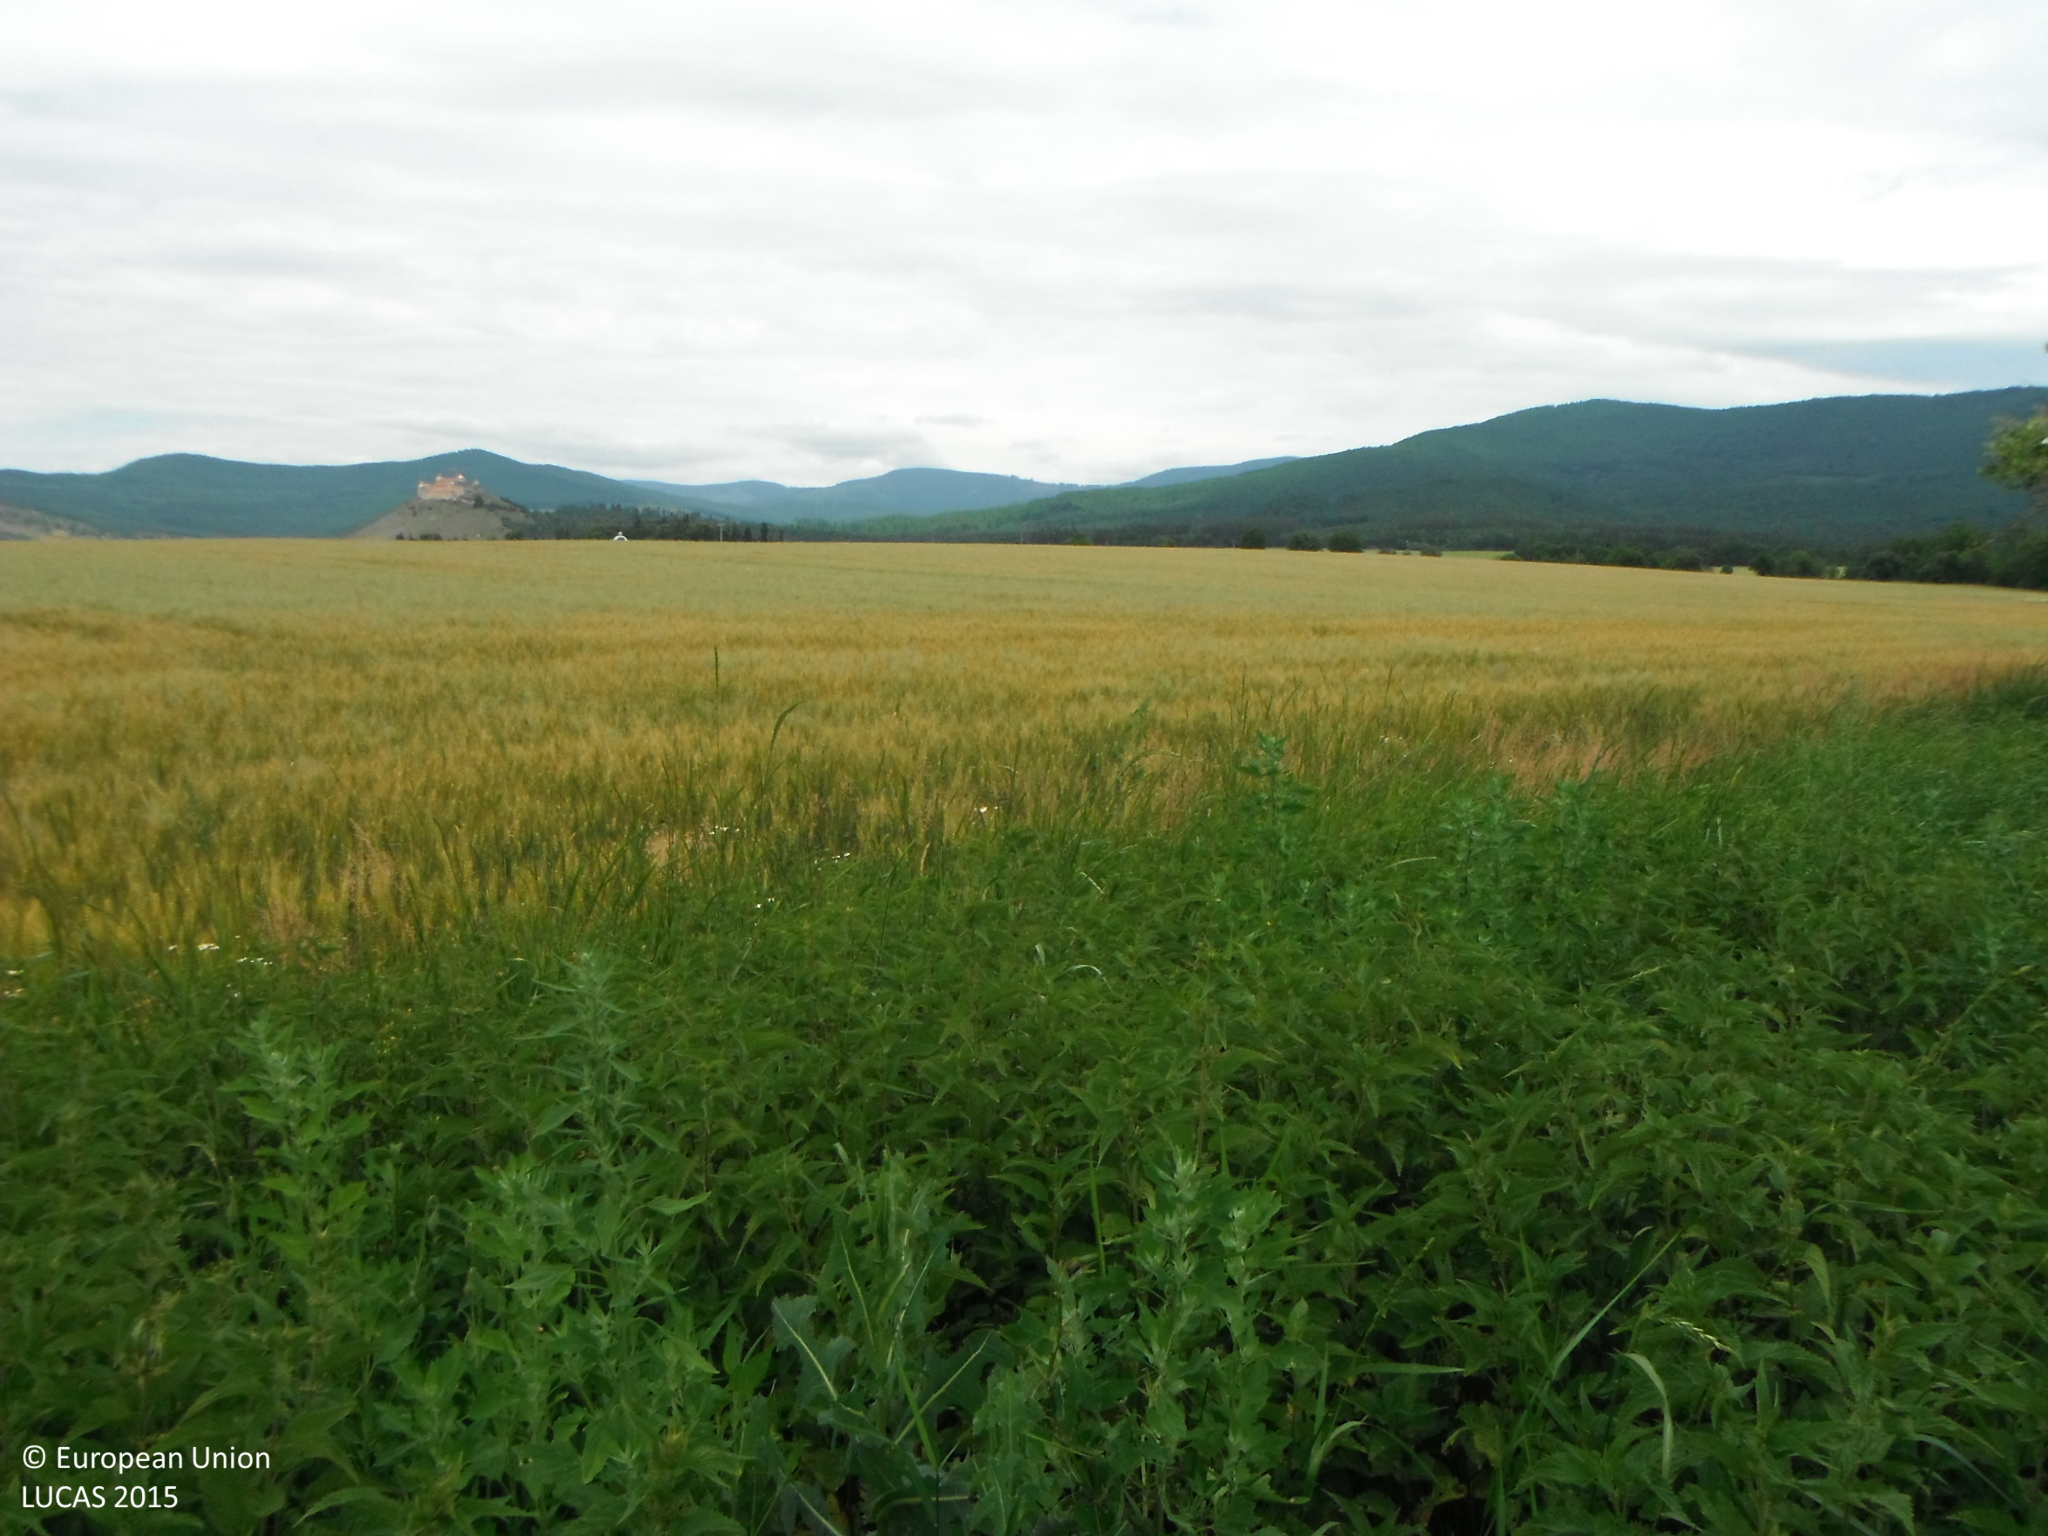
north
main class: Grassland
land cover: Spontaneously vegetated surfaces
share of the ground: > 75 %
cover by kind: herbaceous plants 100 %
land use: Semi-natural and natural areas not in use
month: June
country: SK
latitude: 48.6357
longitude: 20.6074
